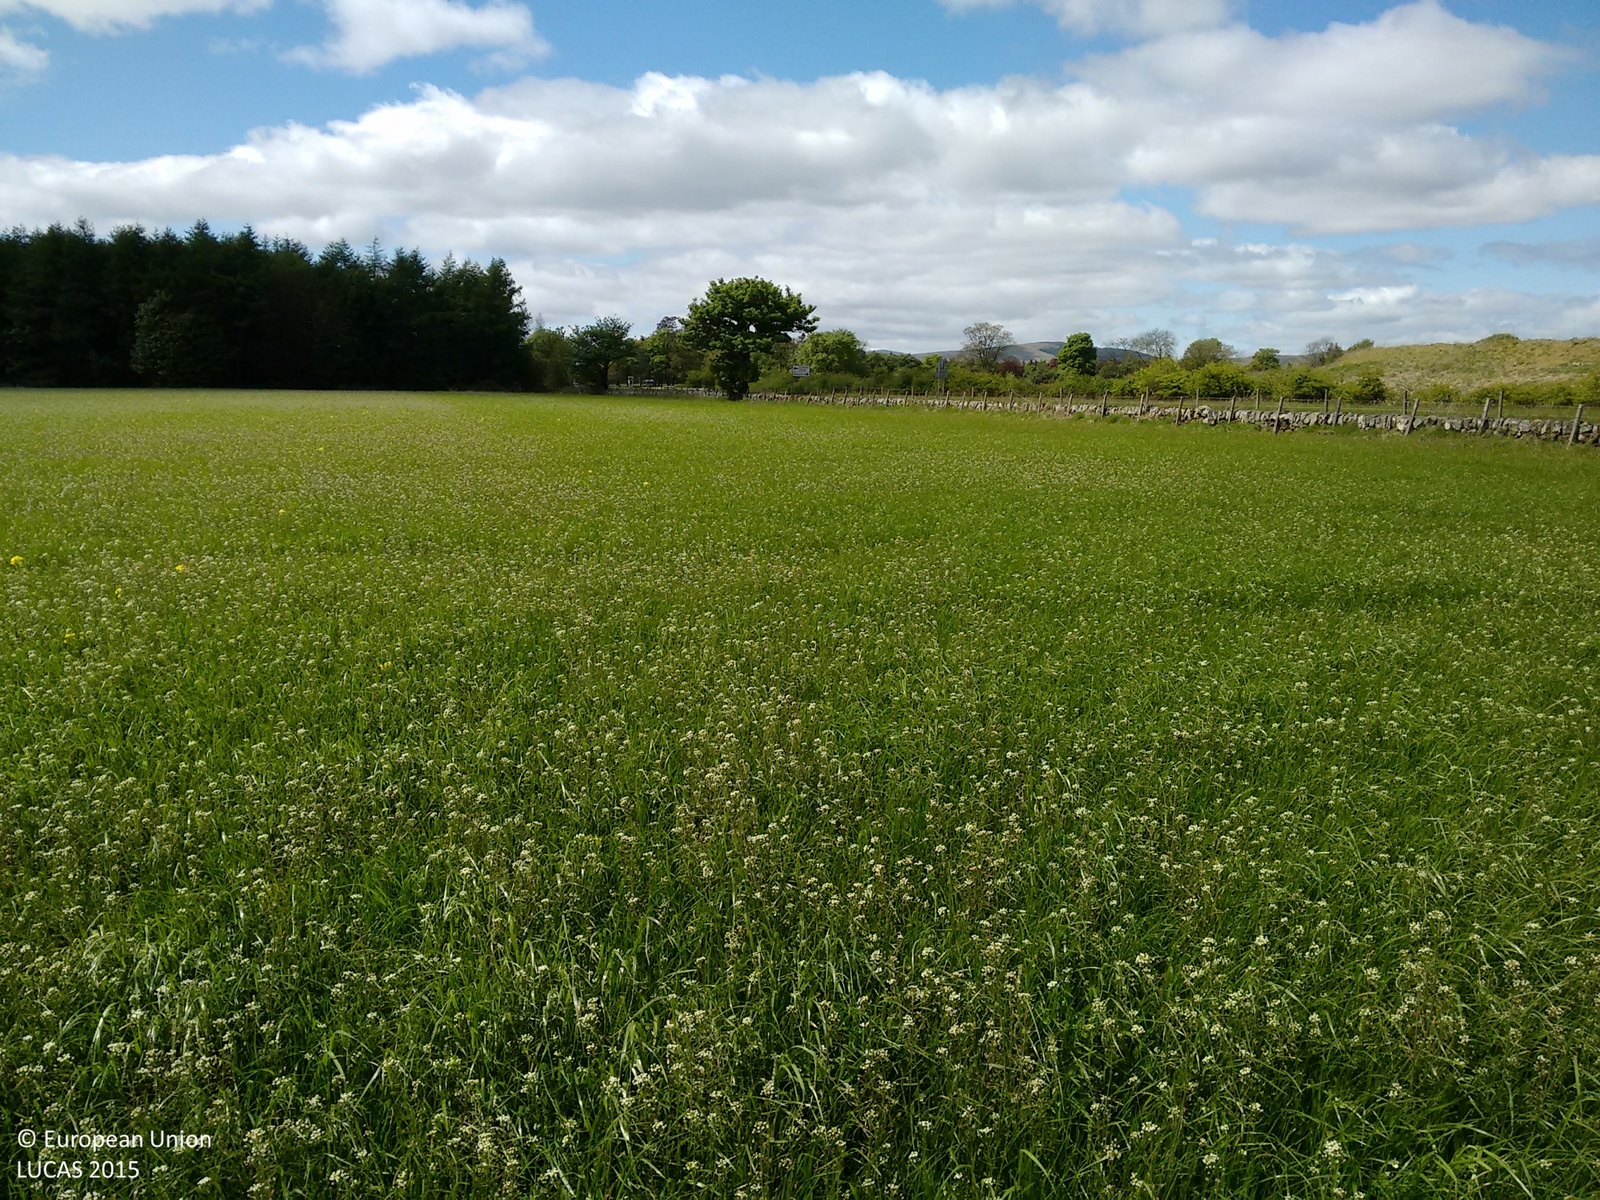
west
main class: Cropland
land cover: Mixed cereals for fodder
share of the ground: > 75 %
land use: Agriculture (excluding fallow land and kitchen gardens)
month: May
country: GB
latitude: 56.2034
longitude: -3.4712
